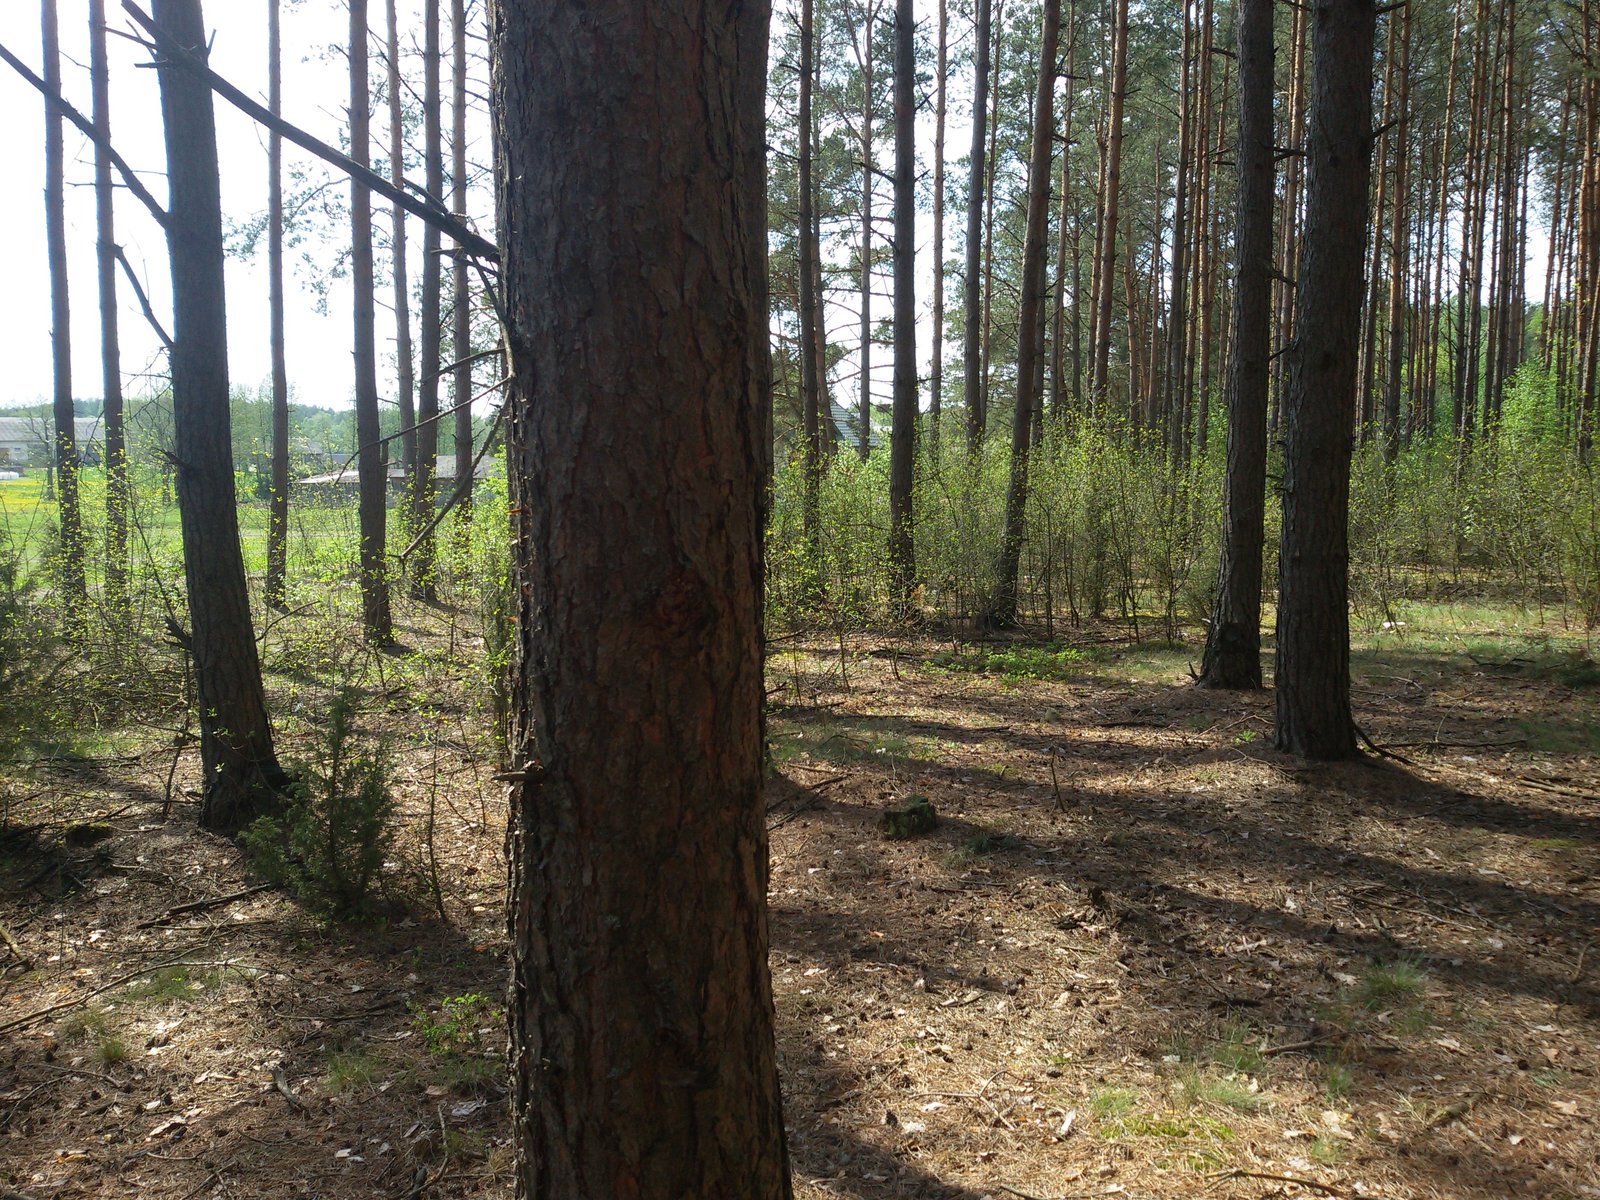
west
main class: Woodland
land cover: Pine dominated coniferous woodland
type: hemiboreal forest and nemoral coniferous forest and mixed broadleaved-coniferous forest
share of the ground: > 75 %
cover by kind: coniferous forest trees 75 %, lichens and mosses 15 %, shrubs 5 %, herbaceous plants 5 %
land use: Forestry
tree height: > 5 m
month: May
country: PL
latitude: 53.0525
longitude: 22.4021
